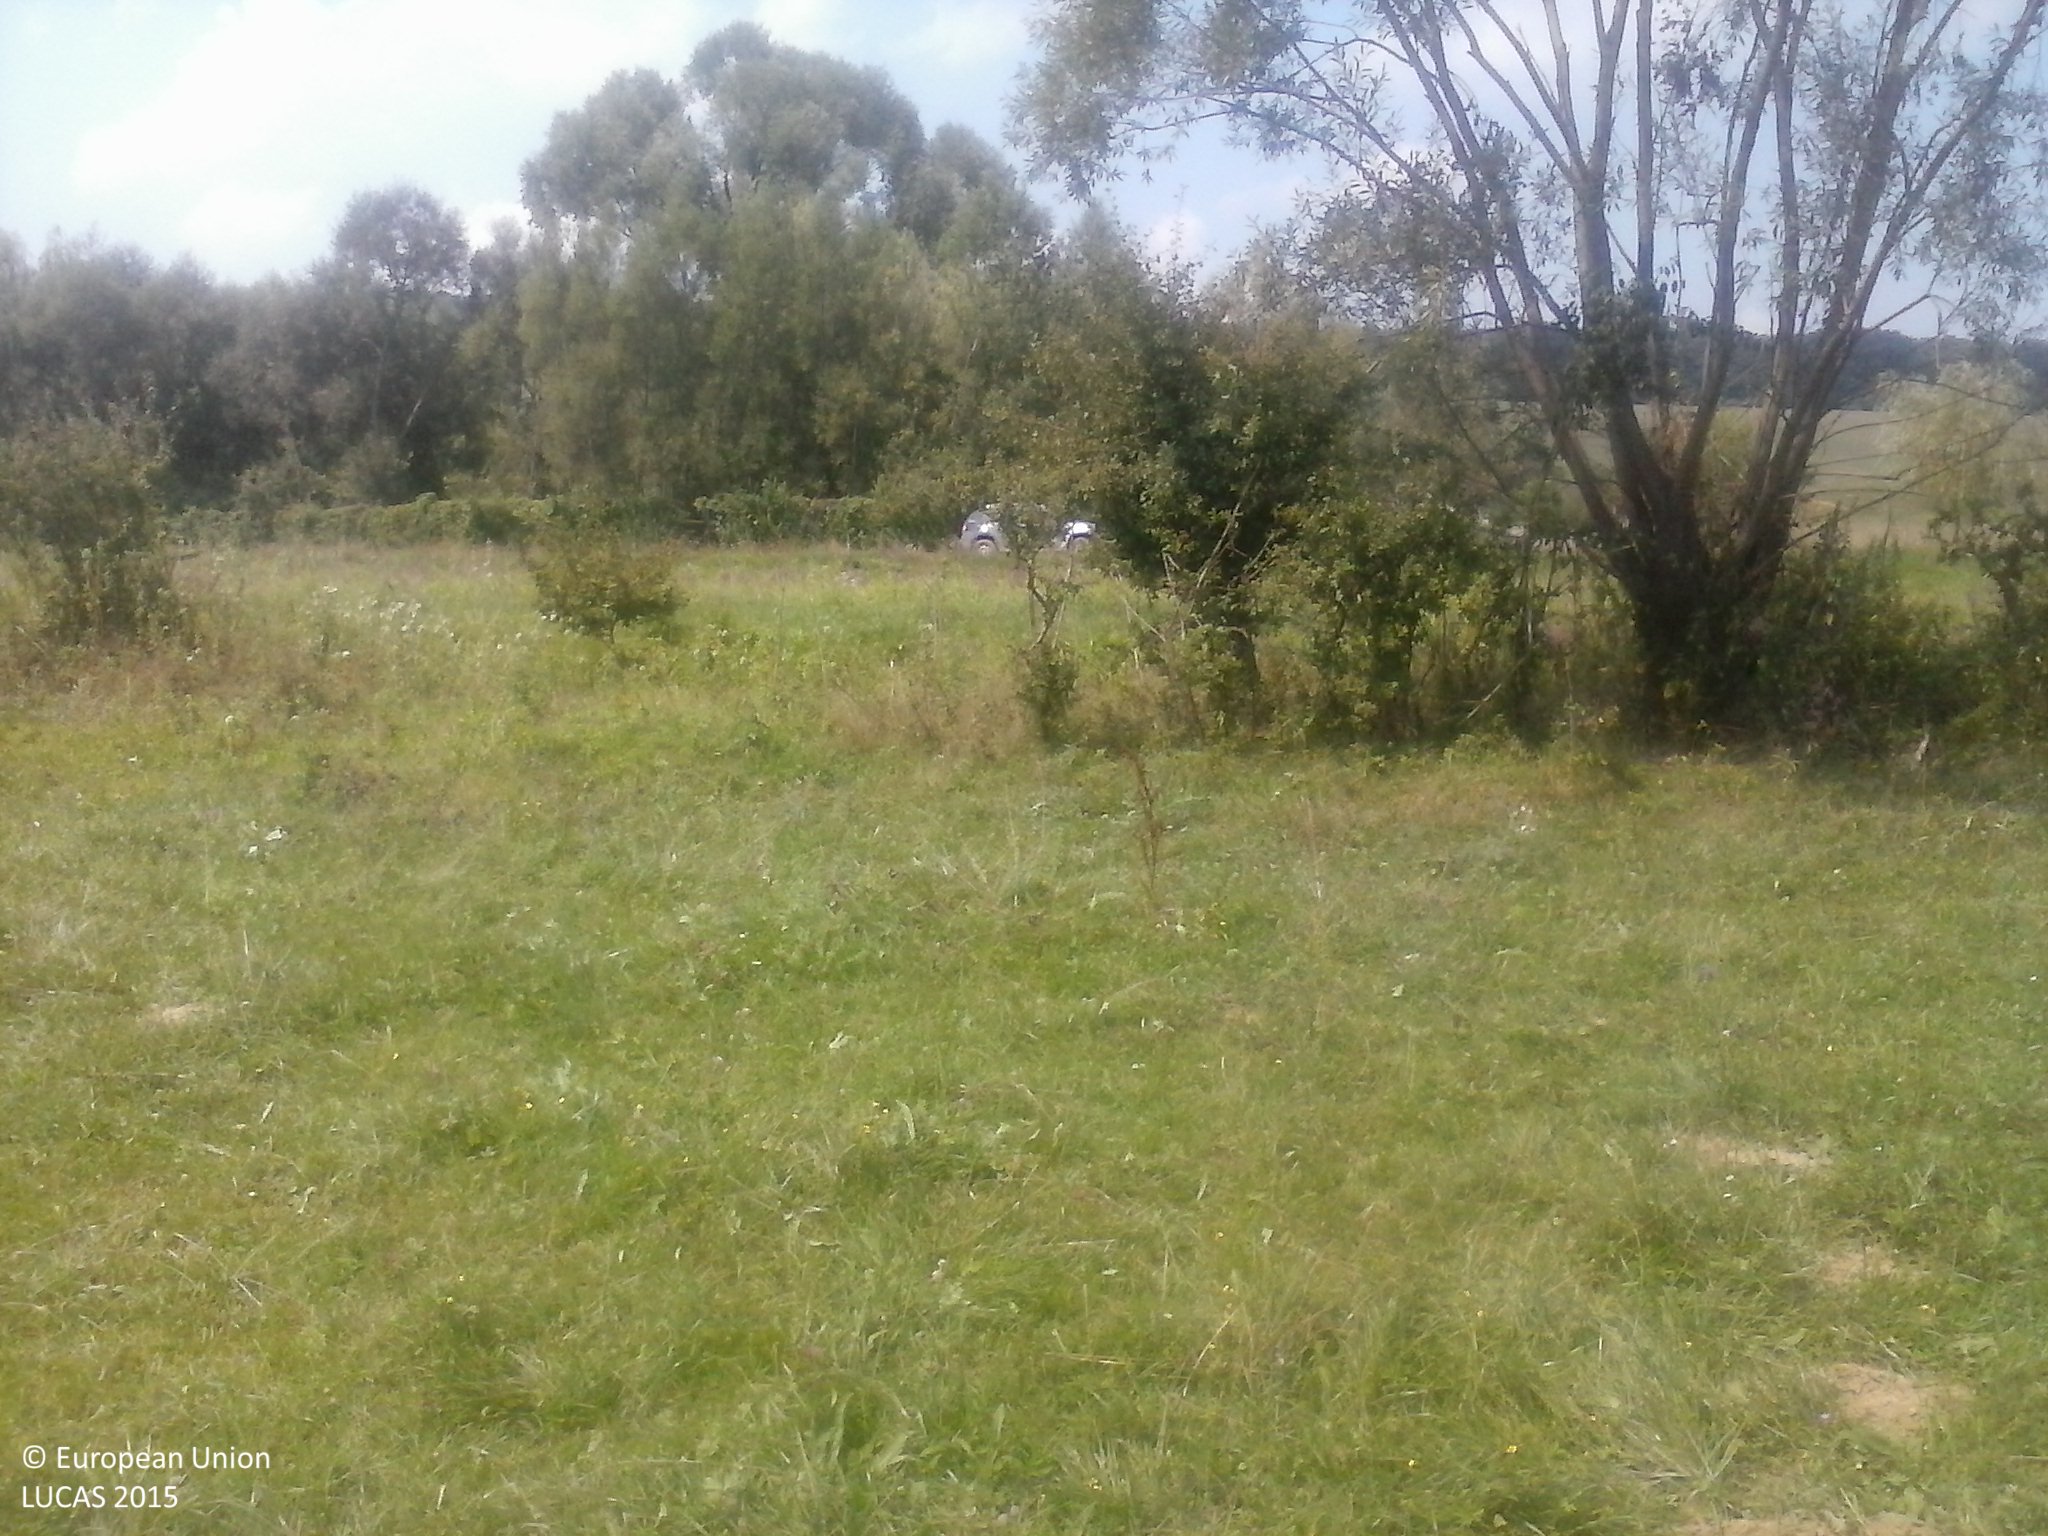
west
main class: Grassland
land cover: Grassland without tree/shrub cover
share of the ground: > 75 %
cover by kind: herbaceous plants 100 %
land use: Agriculture (excluding fallow land and kitchen gardens)
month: August
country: HU
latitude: 46.1838
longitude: 17.9216
